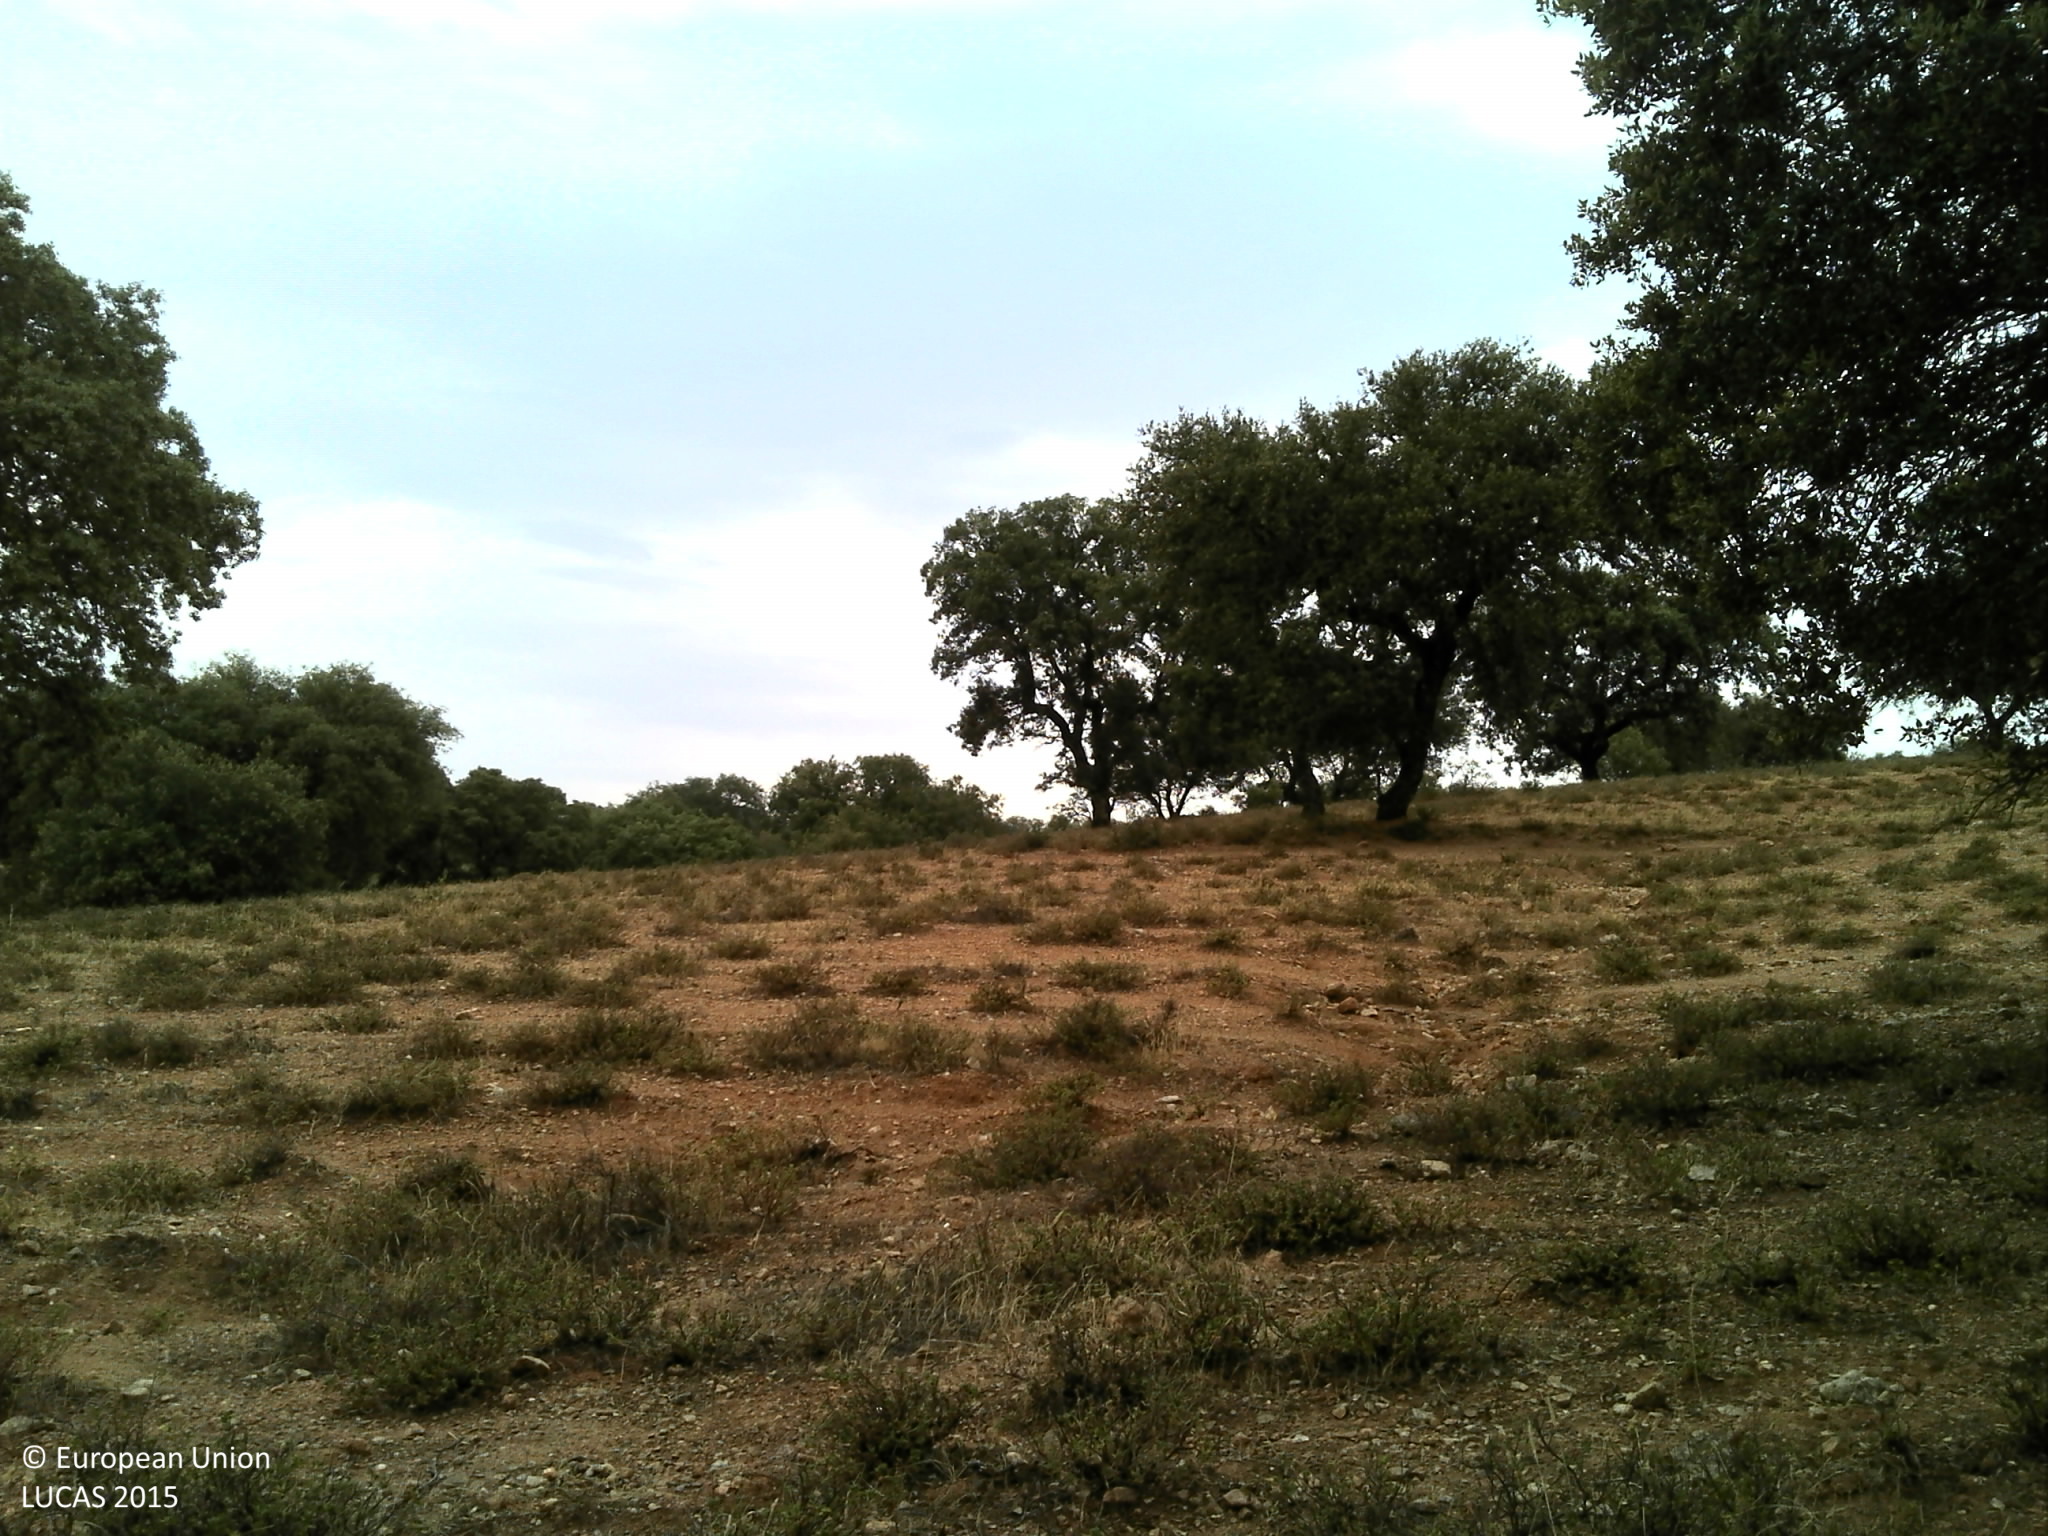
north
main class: Woodland
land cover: Broadleaved woodland
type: broadleaved evergreen forest
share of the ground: 25 - 50 %
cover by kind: broadleaved forest trees 50 %, shrubs 20 %, herbaceous plants 20 %, unconsolidated bare surface 10 %
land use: Forestry
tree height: > 5 m
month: June
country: PT
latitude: 38.6754
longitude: -7.7269
